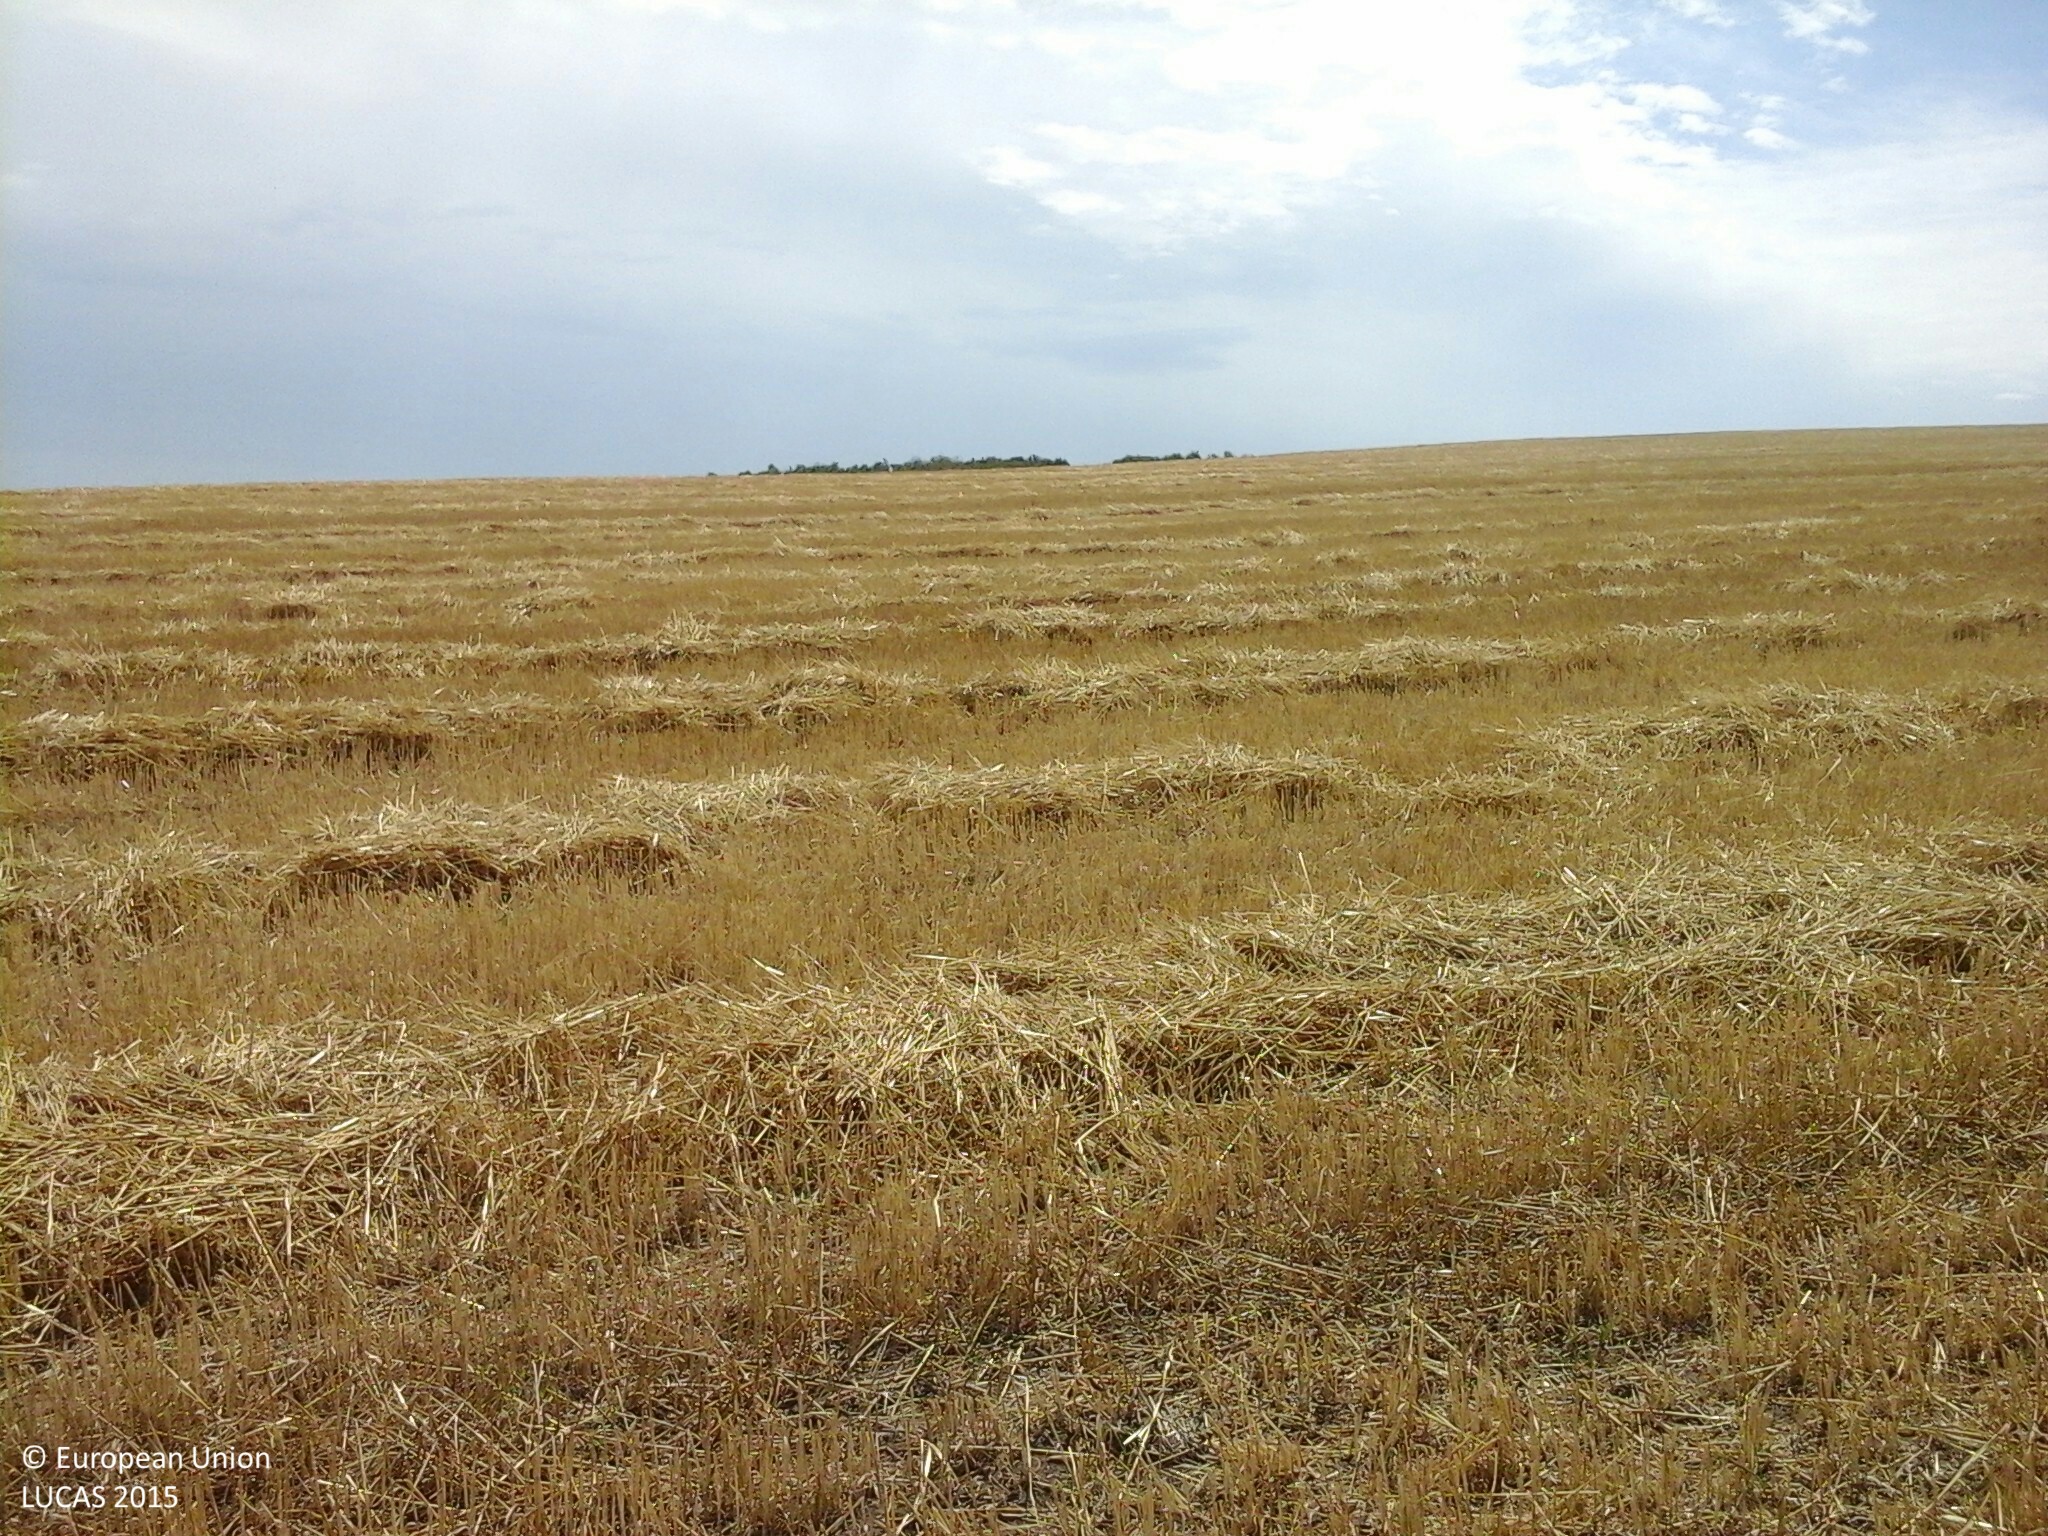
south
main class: Cropland
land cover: Common wheat
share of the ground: 50 - 75 %
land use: Agriculture (excluding fallow land and kitchen gardens)
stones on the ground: < 10 %
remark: Harvested field
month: July
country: HU
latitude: 47.9420
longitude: 20.6509
